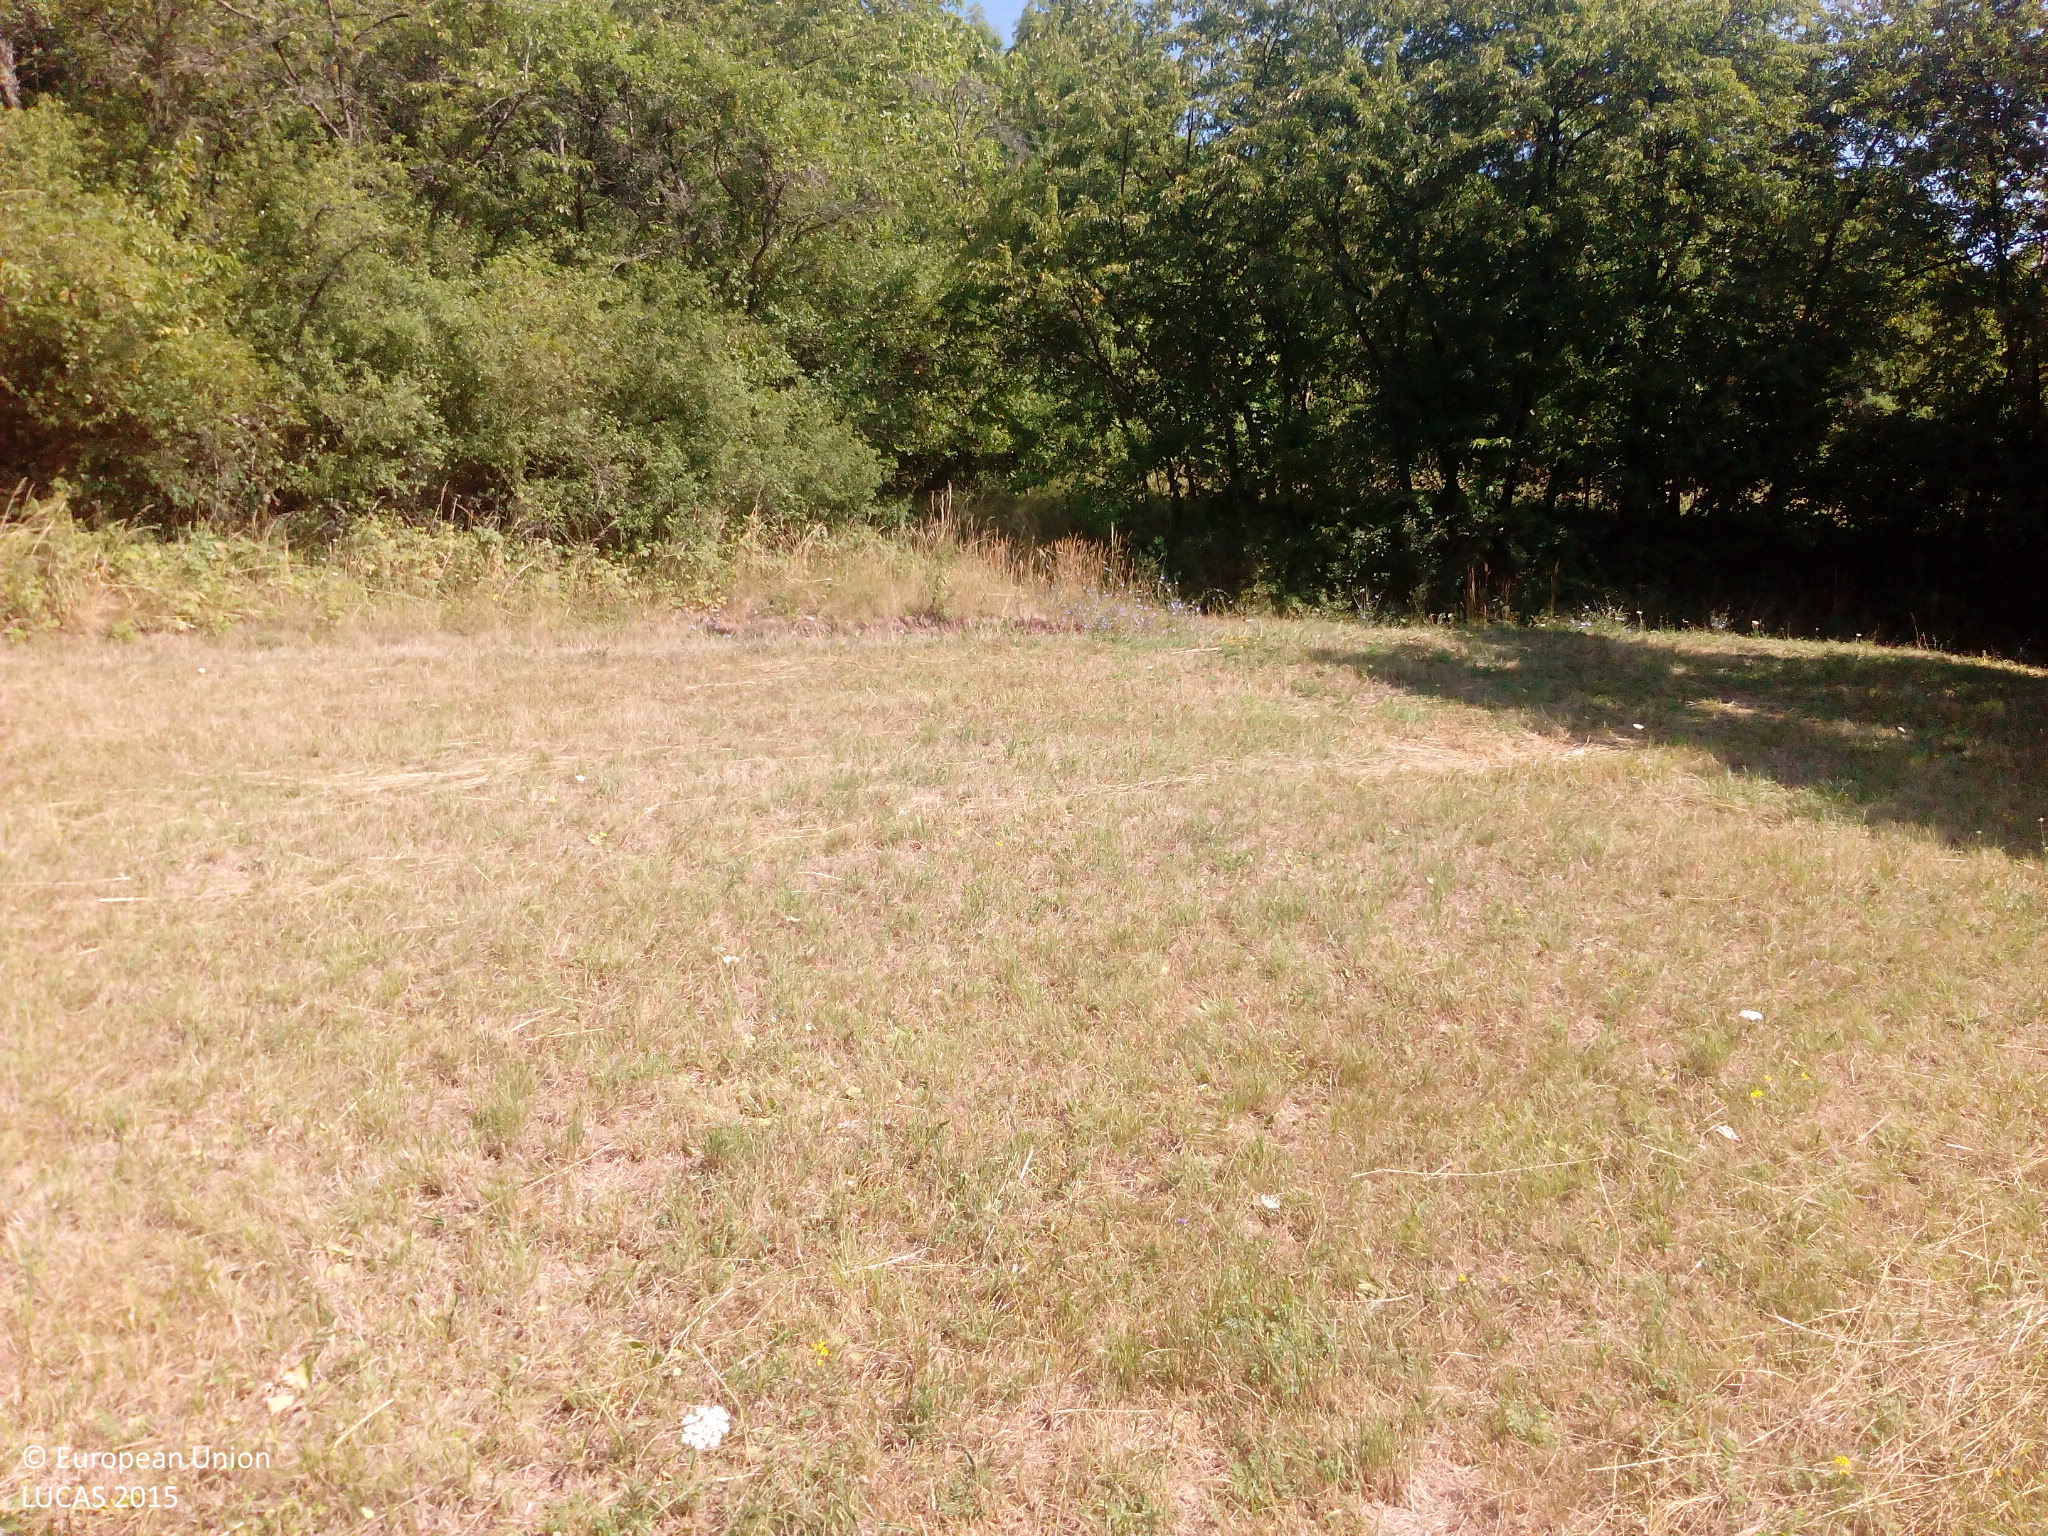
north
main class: Grassland
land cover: Grassland without tree/shrub cover
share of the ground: > 75 %
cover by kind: herbaceous plants 95 %, unconsolidated bare surface 5 %
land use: Agriculture (excluding fallow land and kitchen gardens)
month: July
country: DE
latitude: 49.7452
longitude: 7.5996
